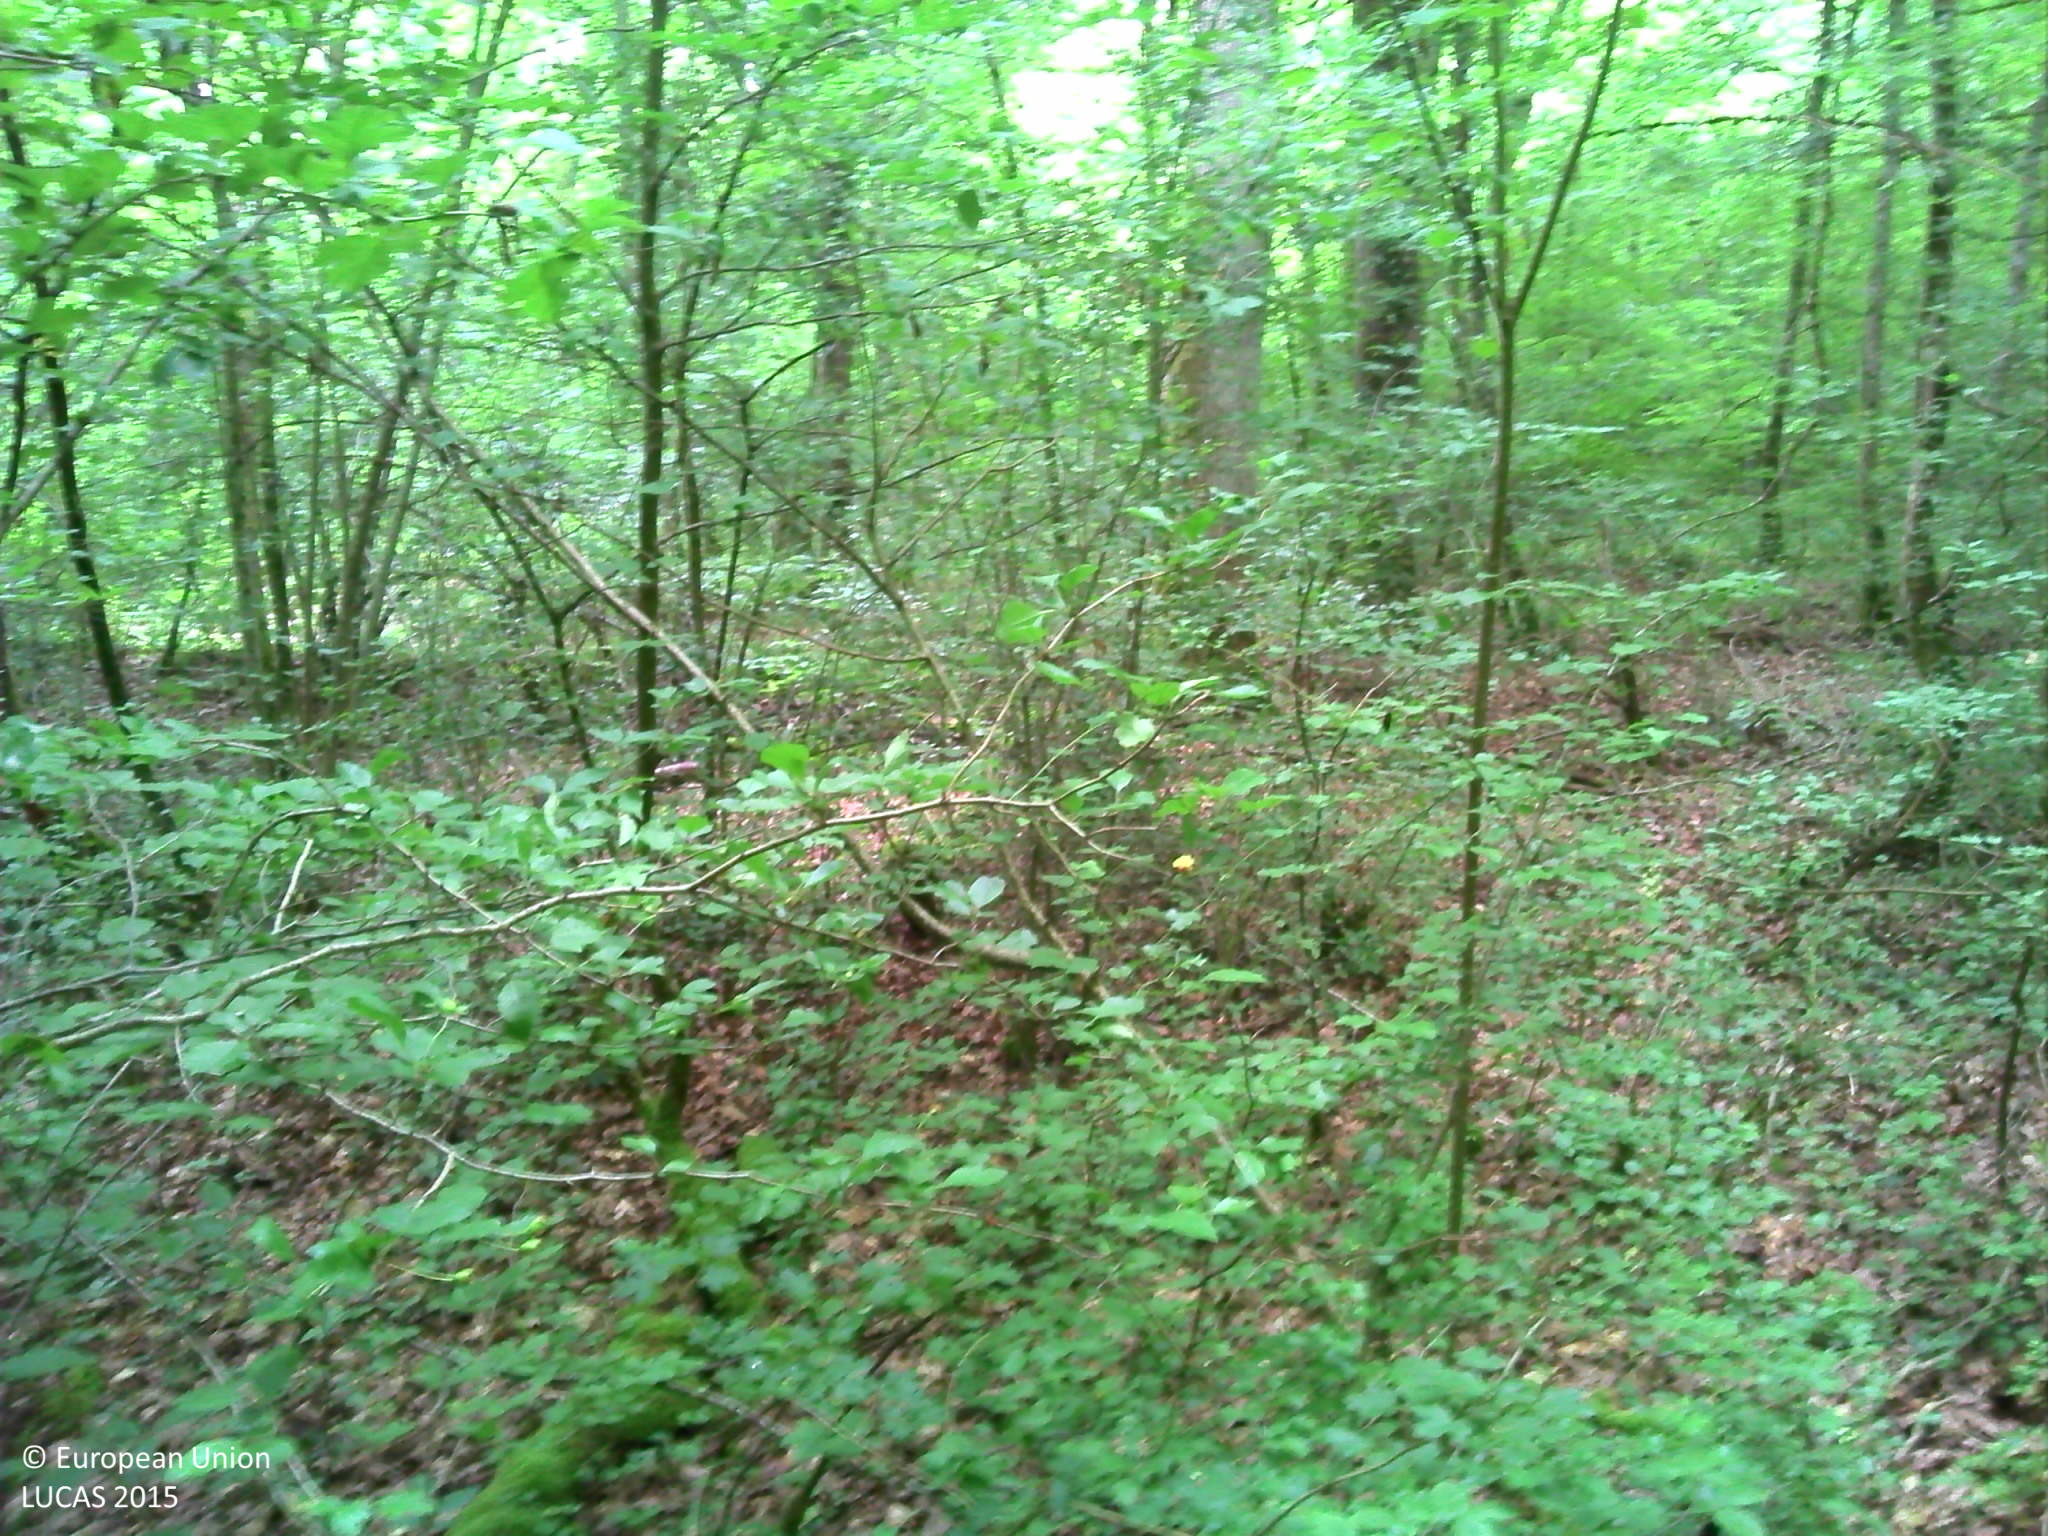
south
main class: Woodland
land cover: Broadleaved woodland
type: mesophytic deciduous forest
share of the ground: > 75 %
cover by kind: broadleaved forest trees 95 %, lichens and mosses 5 %
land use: Forestry
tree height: > 5 m
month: June
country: FR
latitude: 48.7111
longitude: 6.0451
